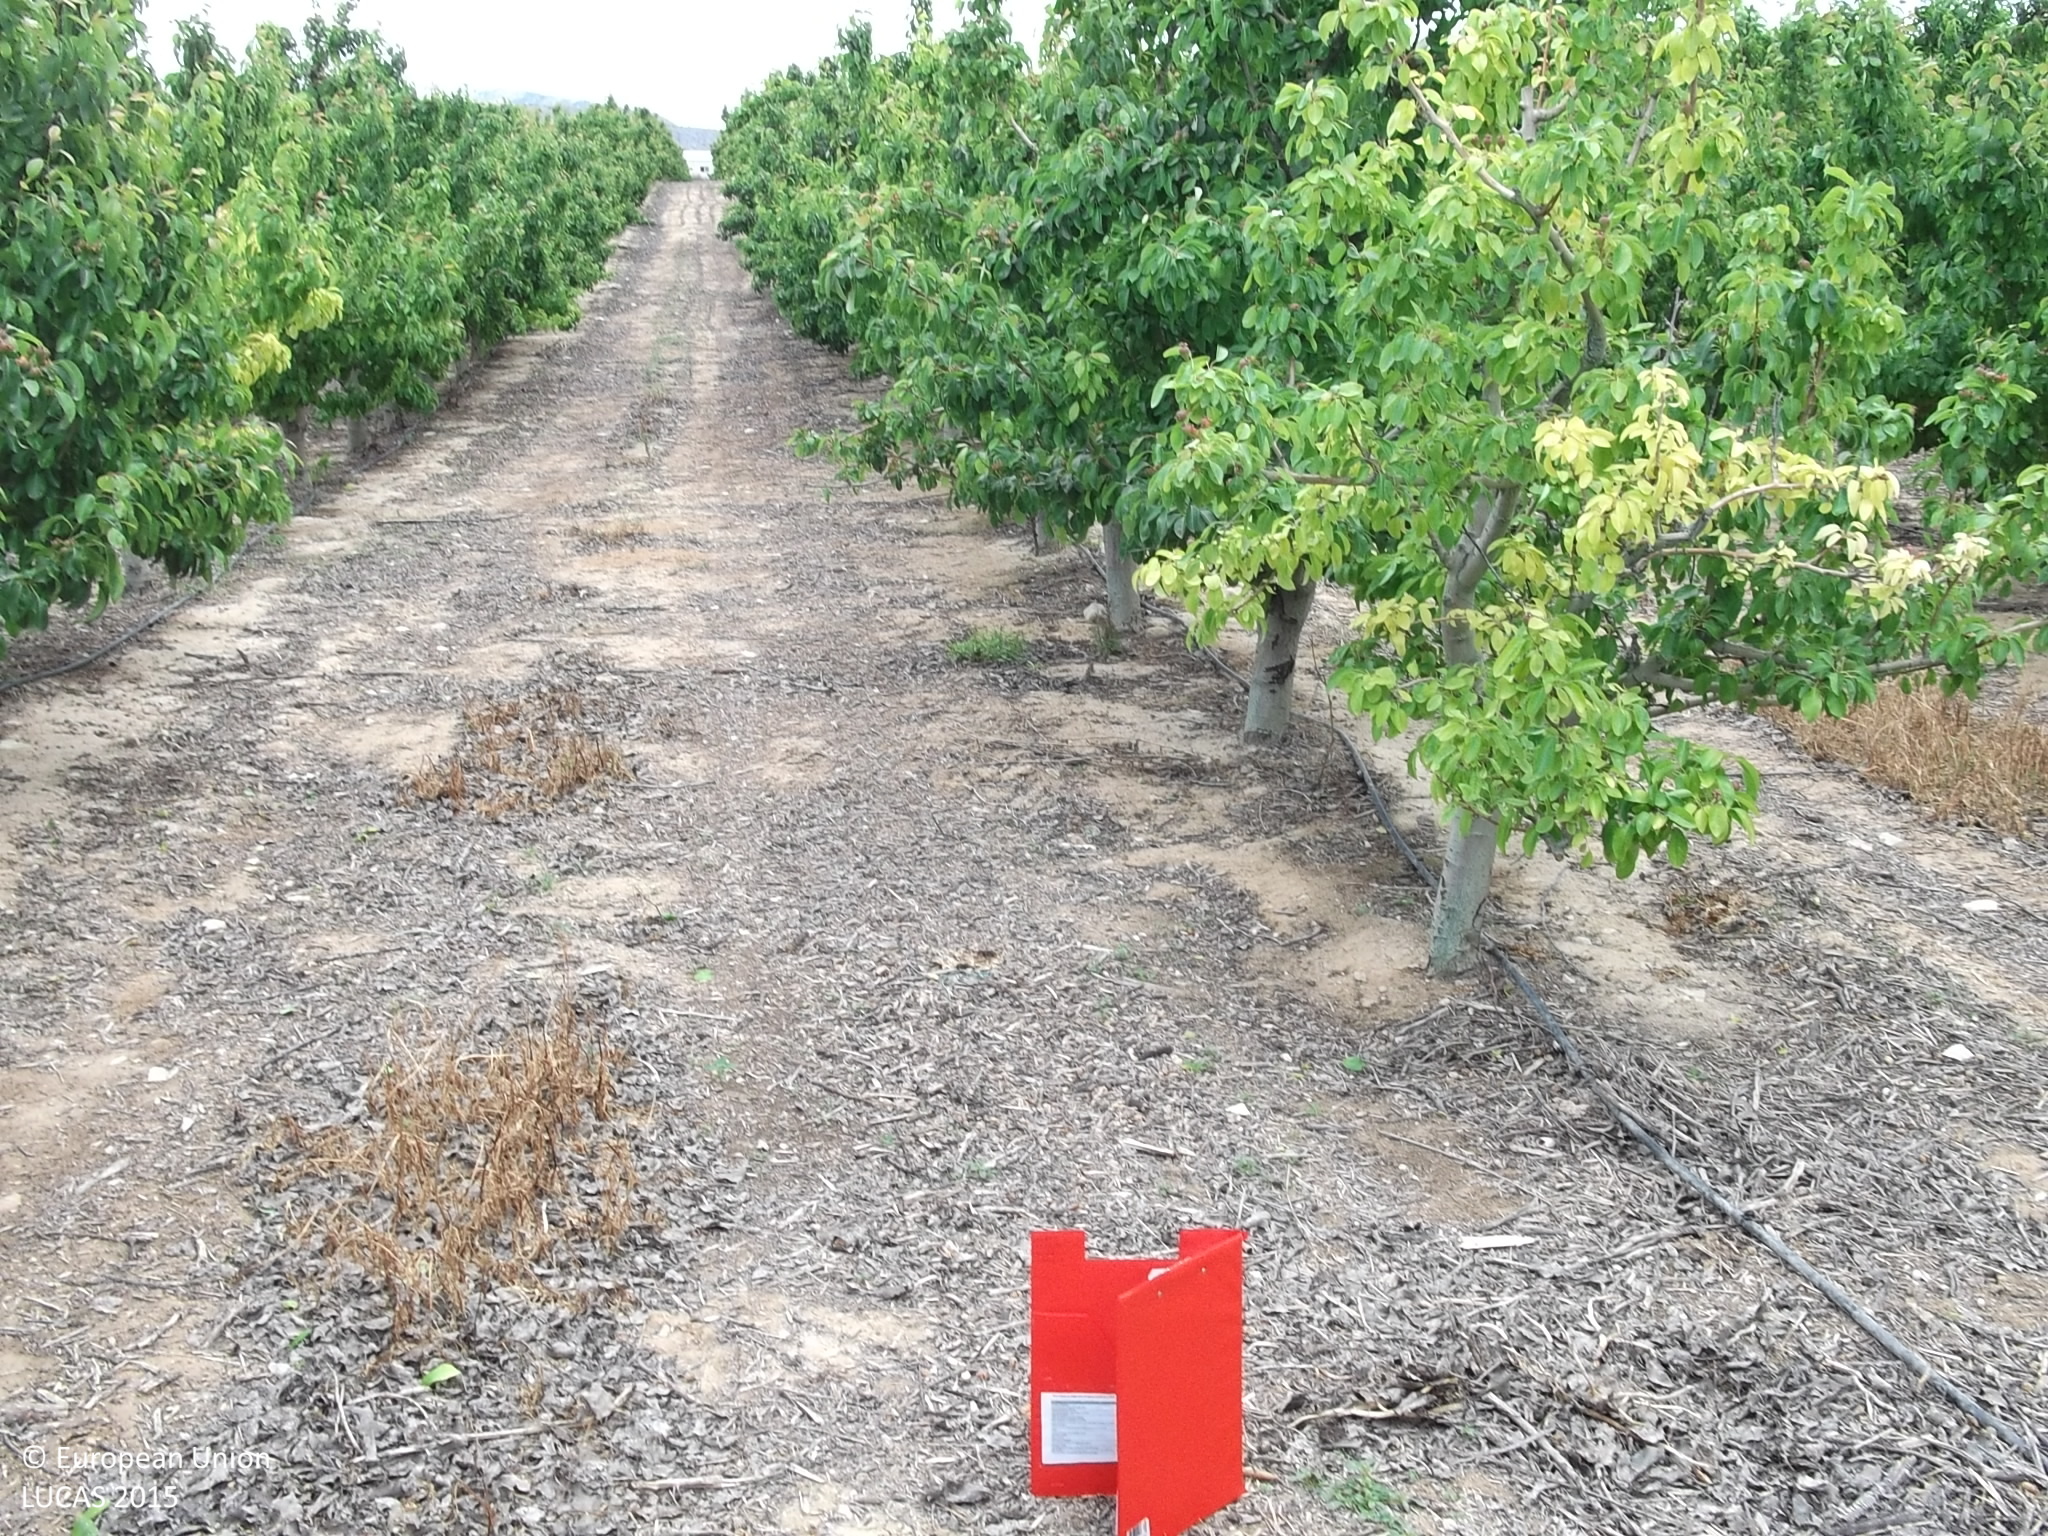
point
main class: Cropland
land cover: Pear fruit
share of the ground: 25 - 50 %
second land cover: Other bare soil
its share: > 75 %
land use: Agriculture (excluding fallow land and kitchen gardens)
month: April
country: ES
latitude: 38.2948
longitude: -1.3196
